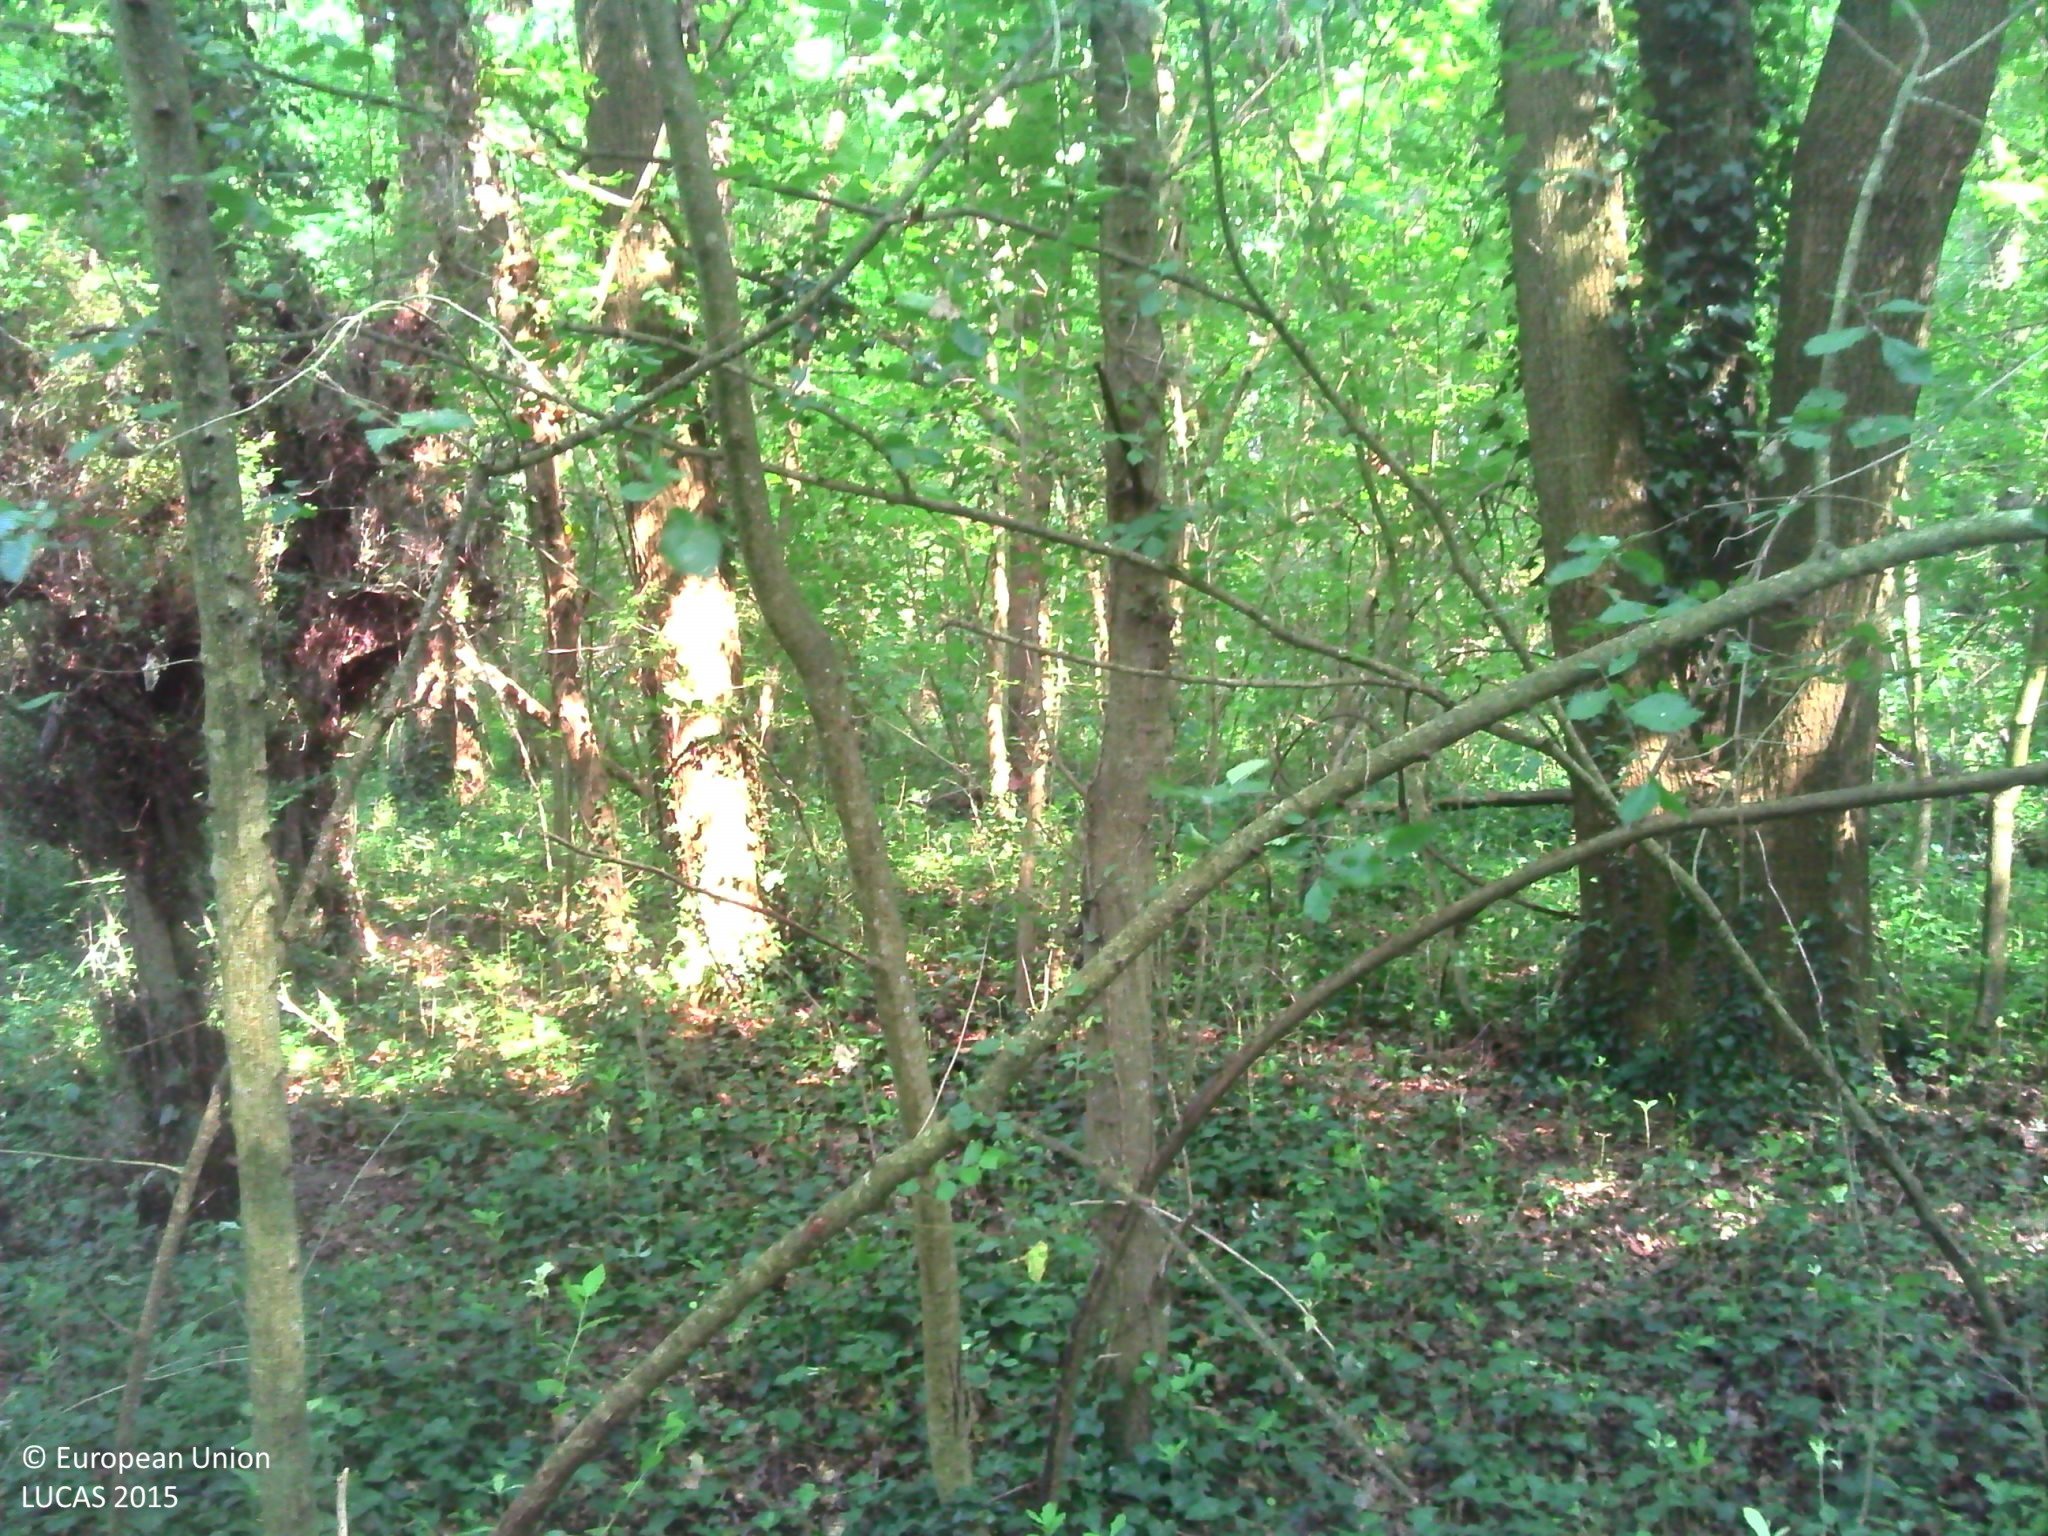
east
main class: Woodland
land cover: Broadleaved woodland
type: mesophytic deciduous forest
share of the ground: > 75 %
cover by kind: broadleaved forest trees 80 %, herbaceous plants 10 %, shrubs 5 %, lichens and mosses 5 %
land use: Forestry
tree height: > 5 m
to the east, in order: Broadleaved woodland; Pine dominated coniferous woodland; Broadleaved woodland; Grass margins; Tracks; Grass margins; Broadleaved woodland; Fences; Grassland without tree/shrub cover
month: July
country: FR
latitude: 47.2136
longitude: 0.0864
